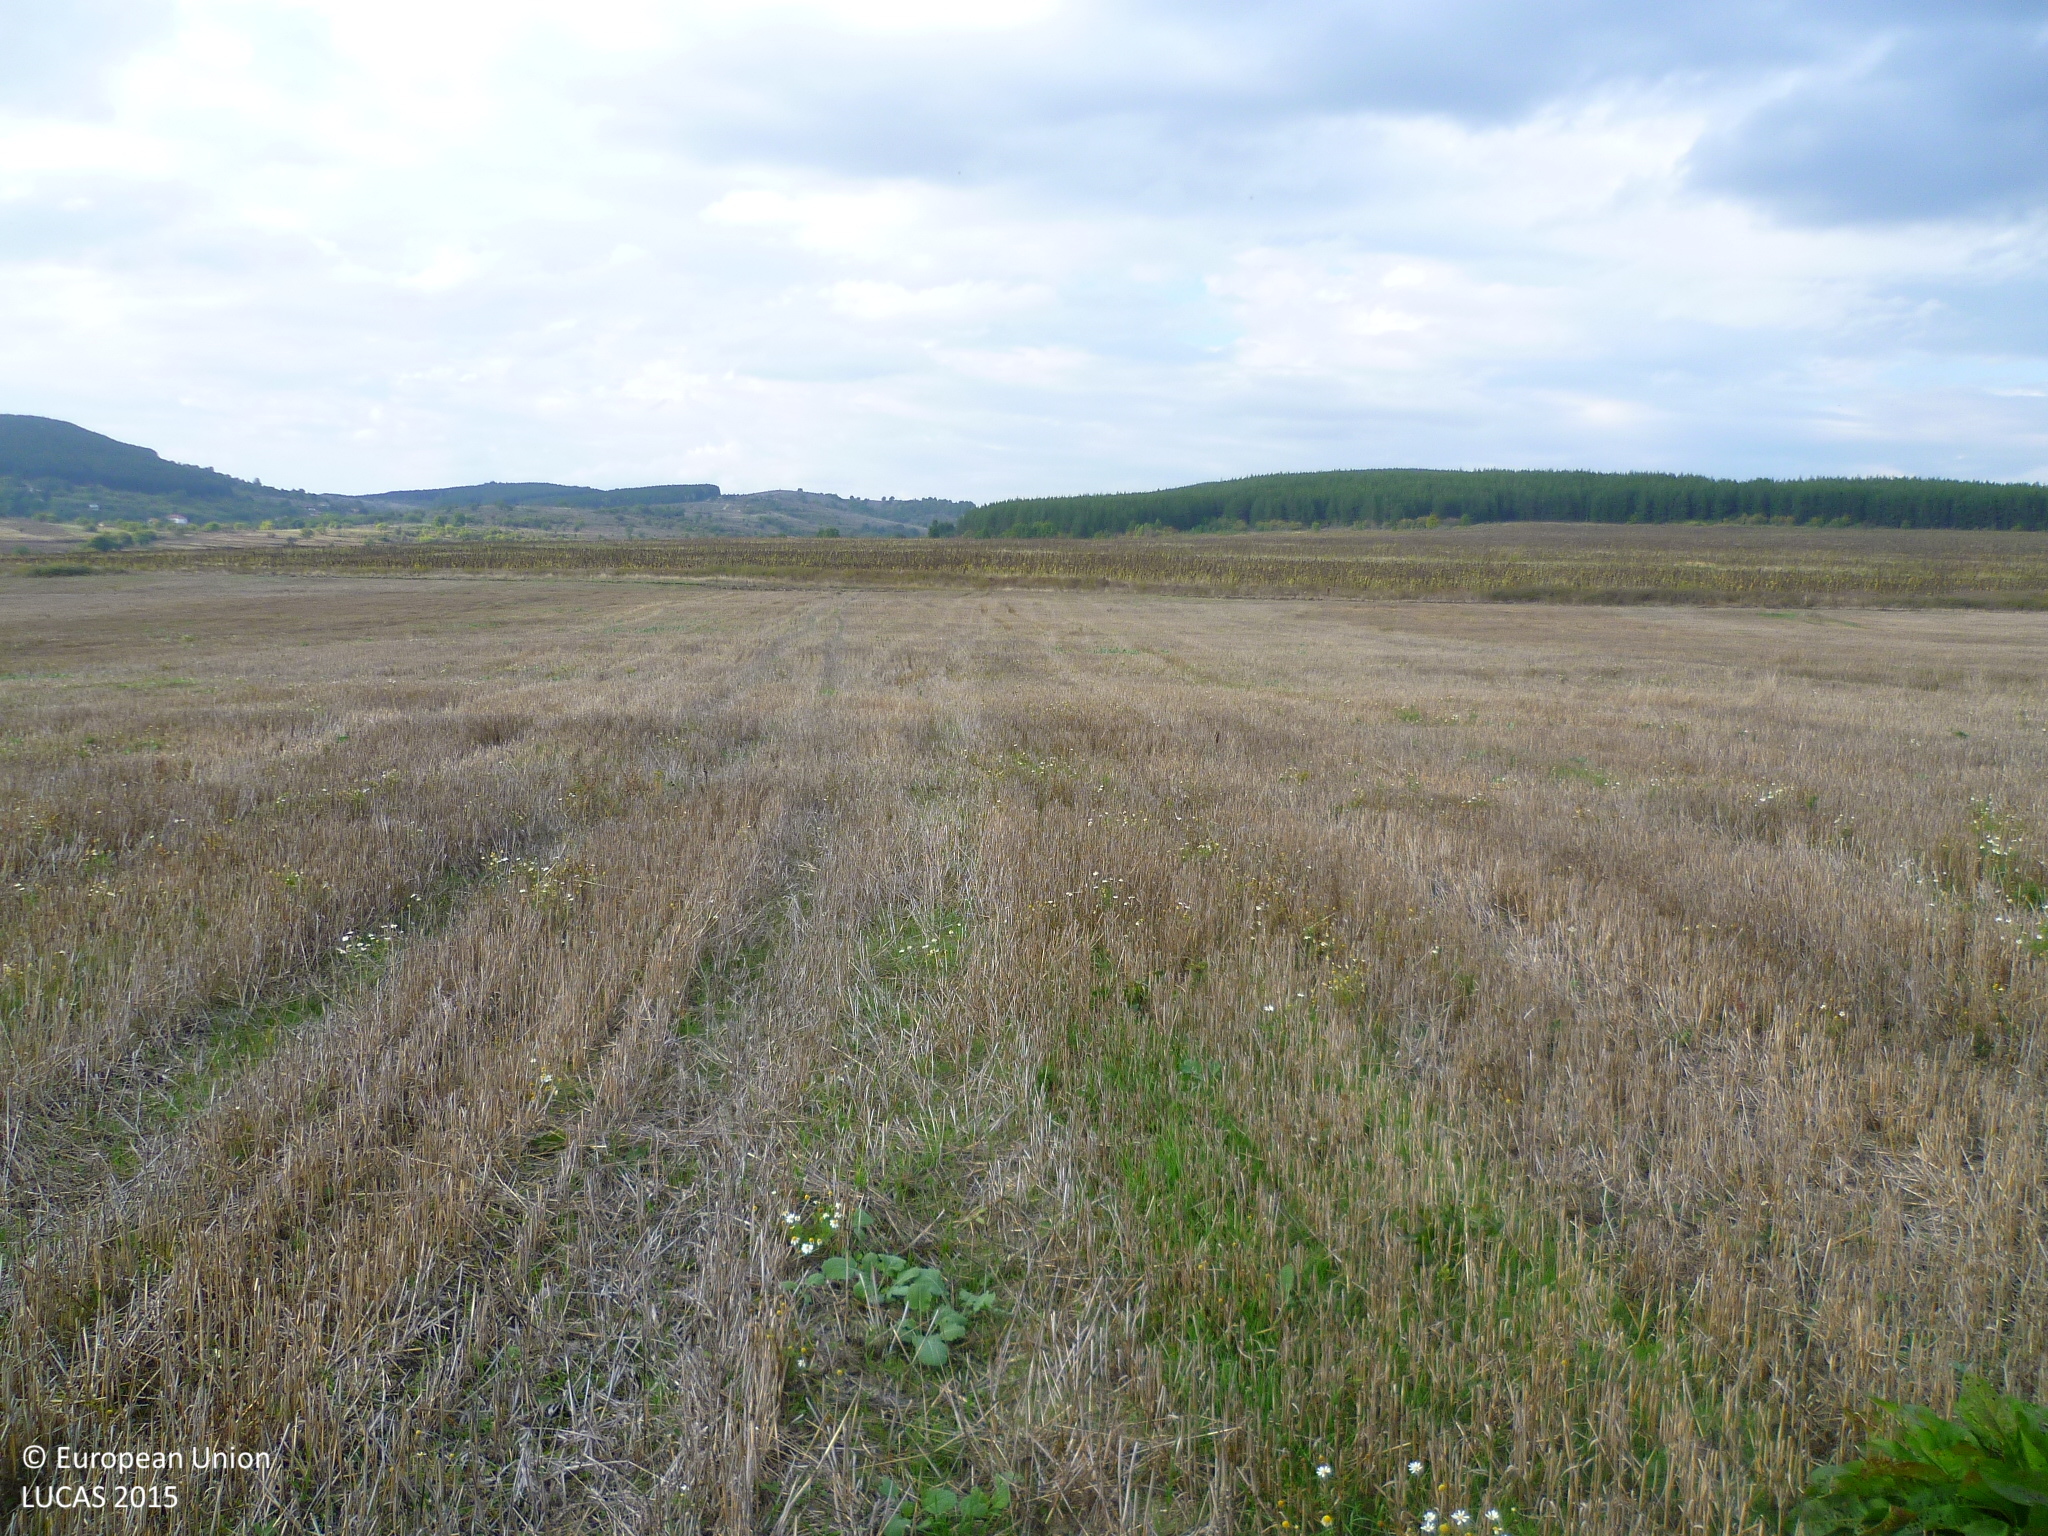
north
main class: Cropland
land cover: Rye
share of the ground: 50 - 75 %
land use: Agriculture (excluding fallow land and kitchen gardens)
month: October
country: BG
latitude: 42.9086
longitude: 22.8541
